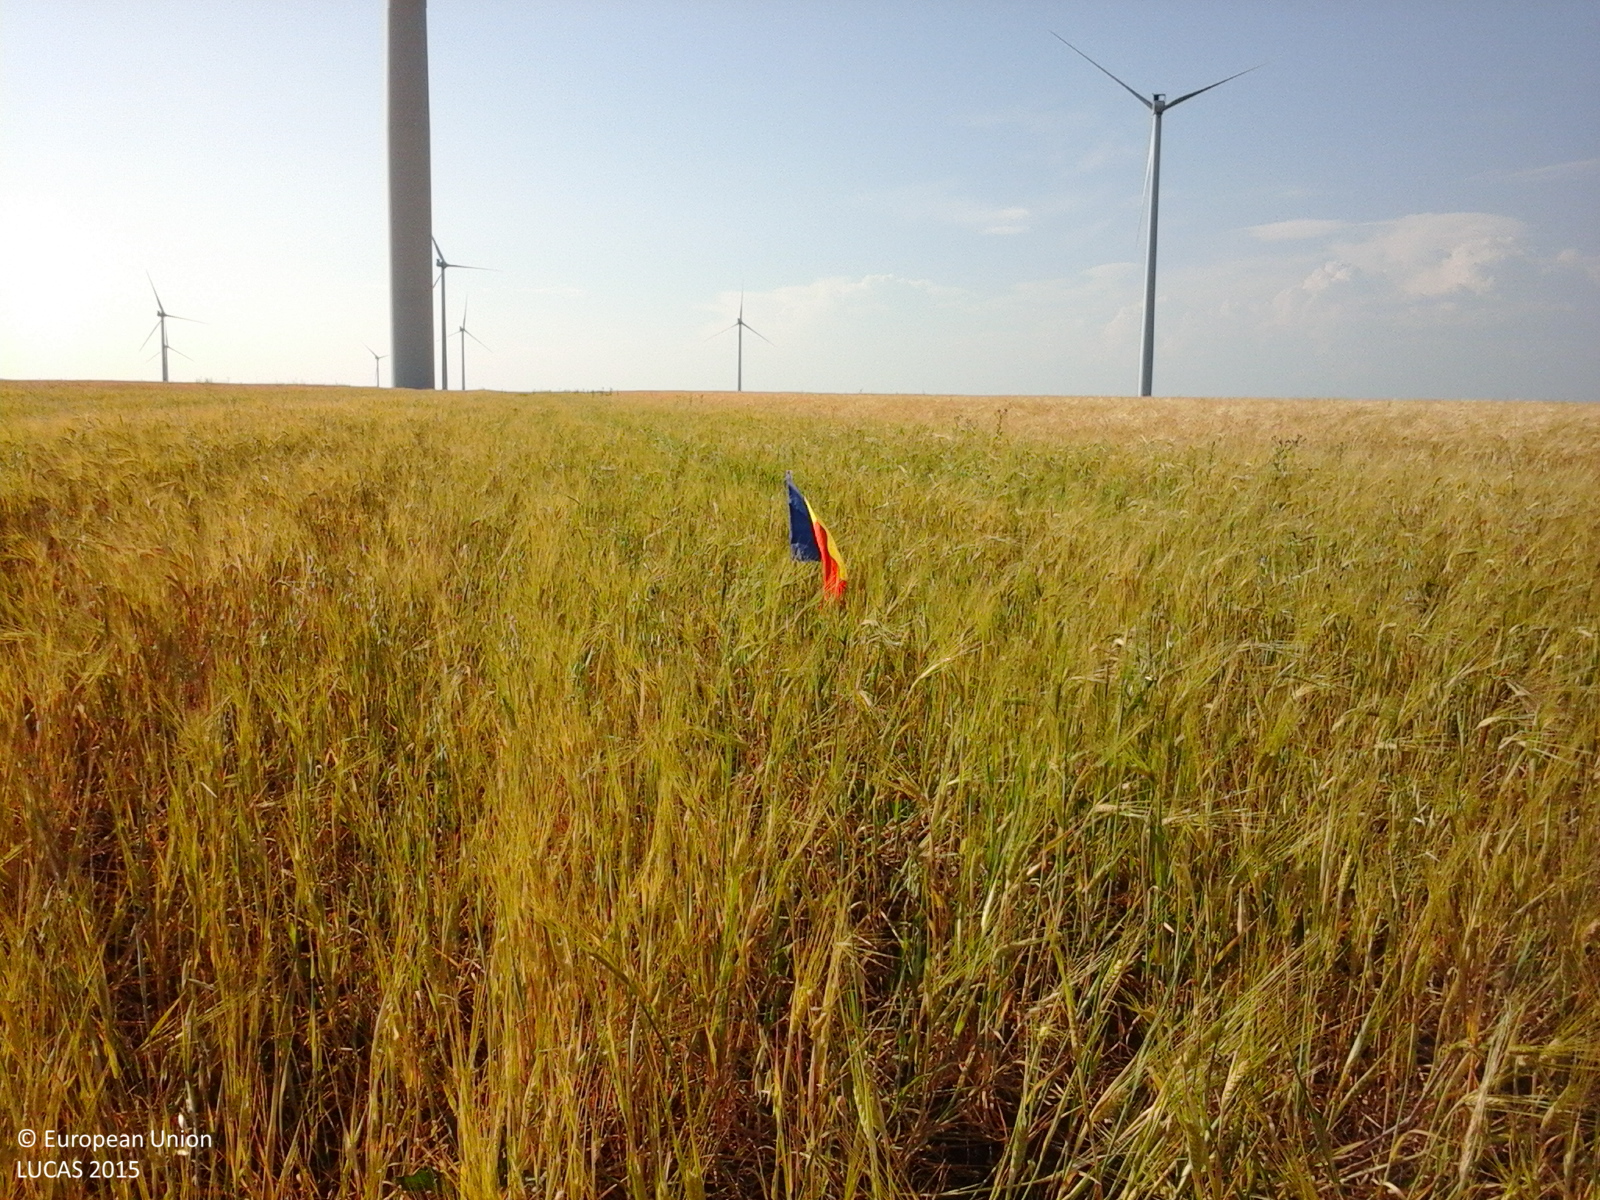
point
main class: Cropland
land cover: Barley
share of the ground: > 75 %
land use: Agriculture (excluding fallow land and kitchen gardens)
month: June
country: RO
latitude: 46.8011
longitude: 28.0958
